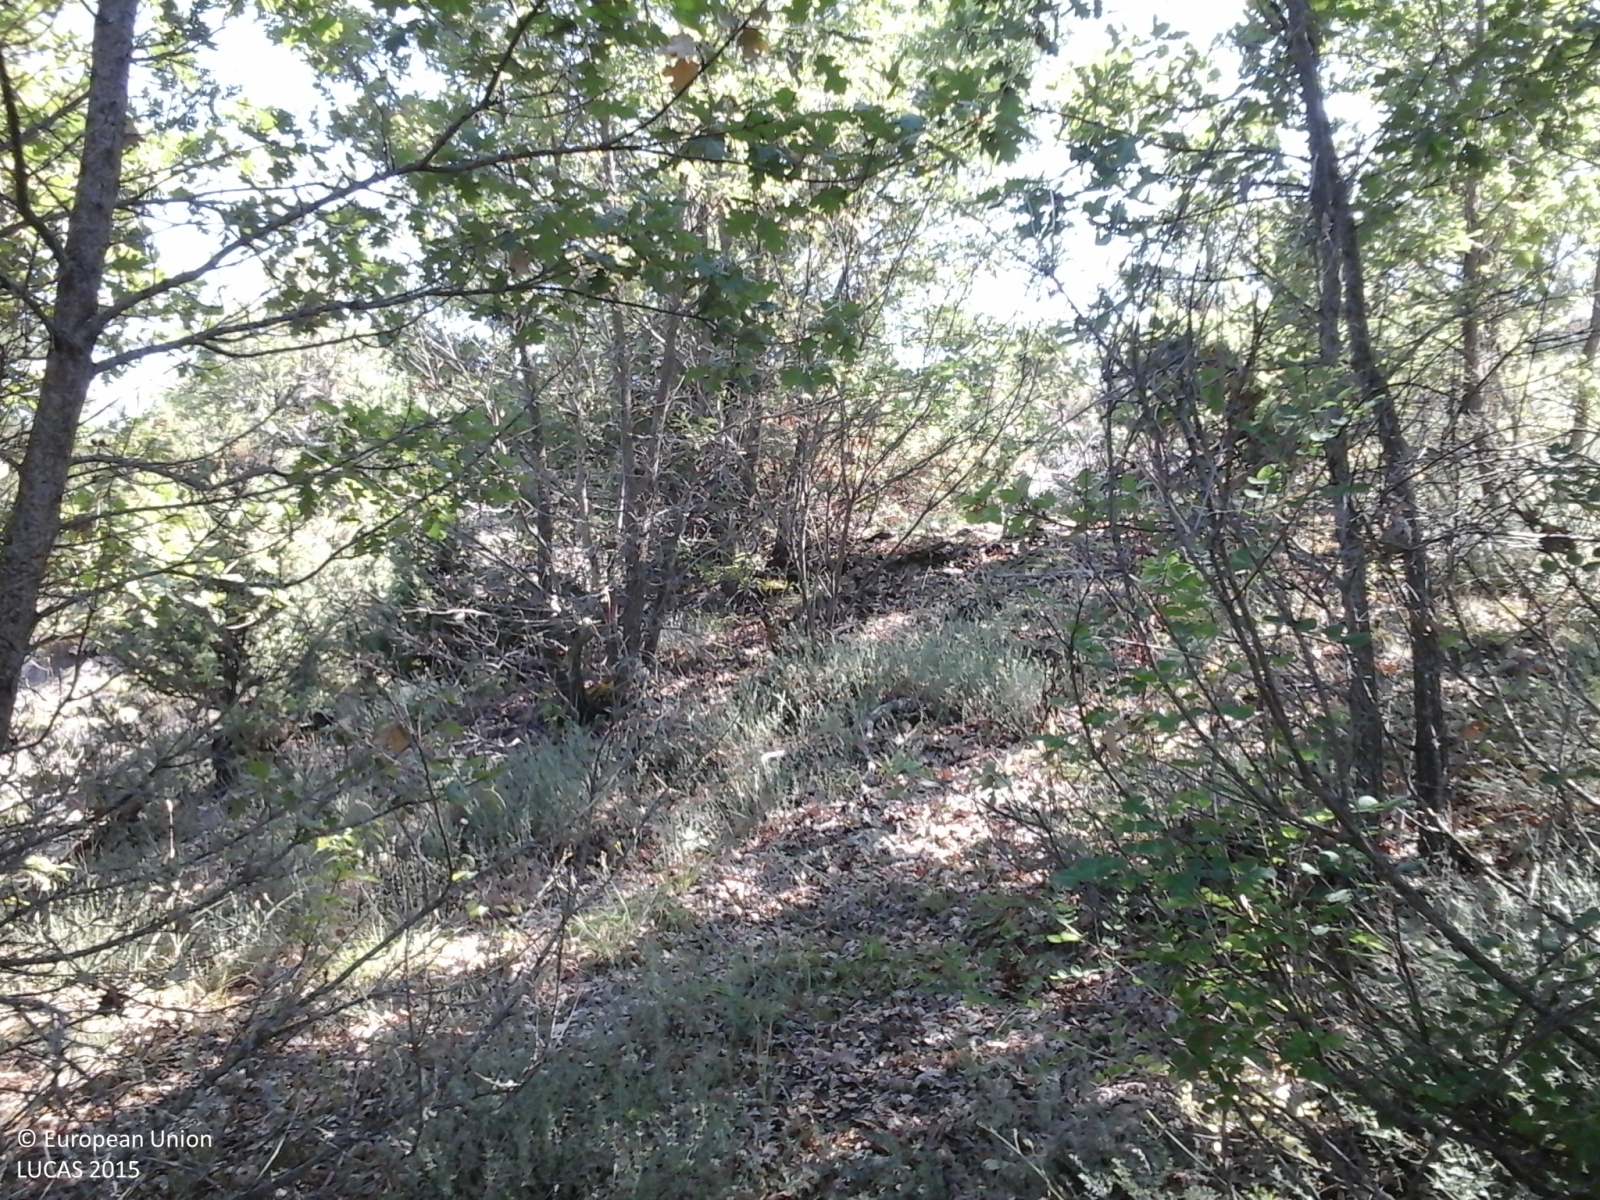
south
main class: Woodland
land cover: Broadleaved woodland
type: thermophilous deciduous forest
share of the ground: 50 - 75 %
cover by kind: broadleaved forest trees 60 %, herbaceous plants 35 %, shrubs 5 %
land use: Forestry
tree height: > 5 m
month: July
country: GR
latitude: 40.2858
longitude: 21.3152
